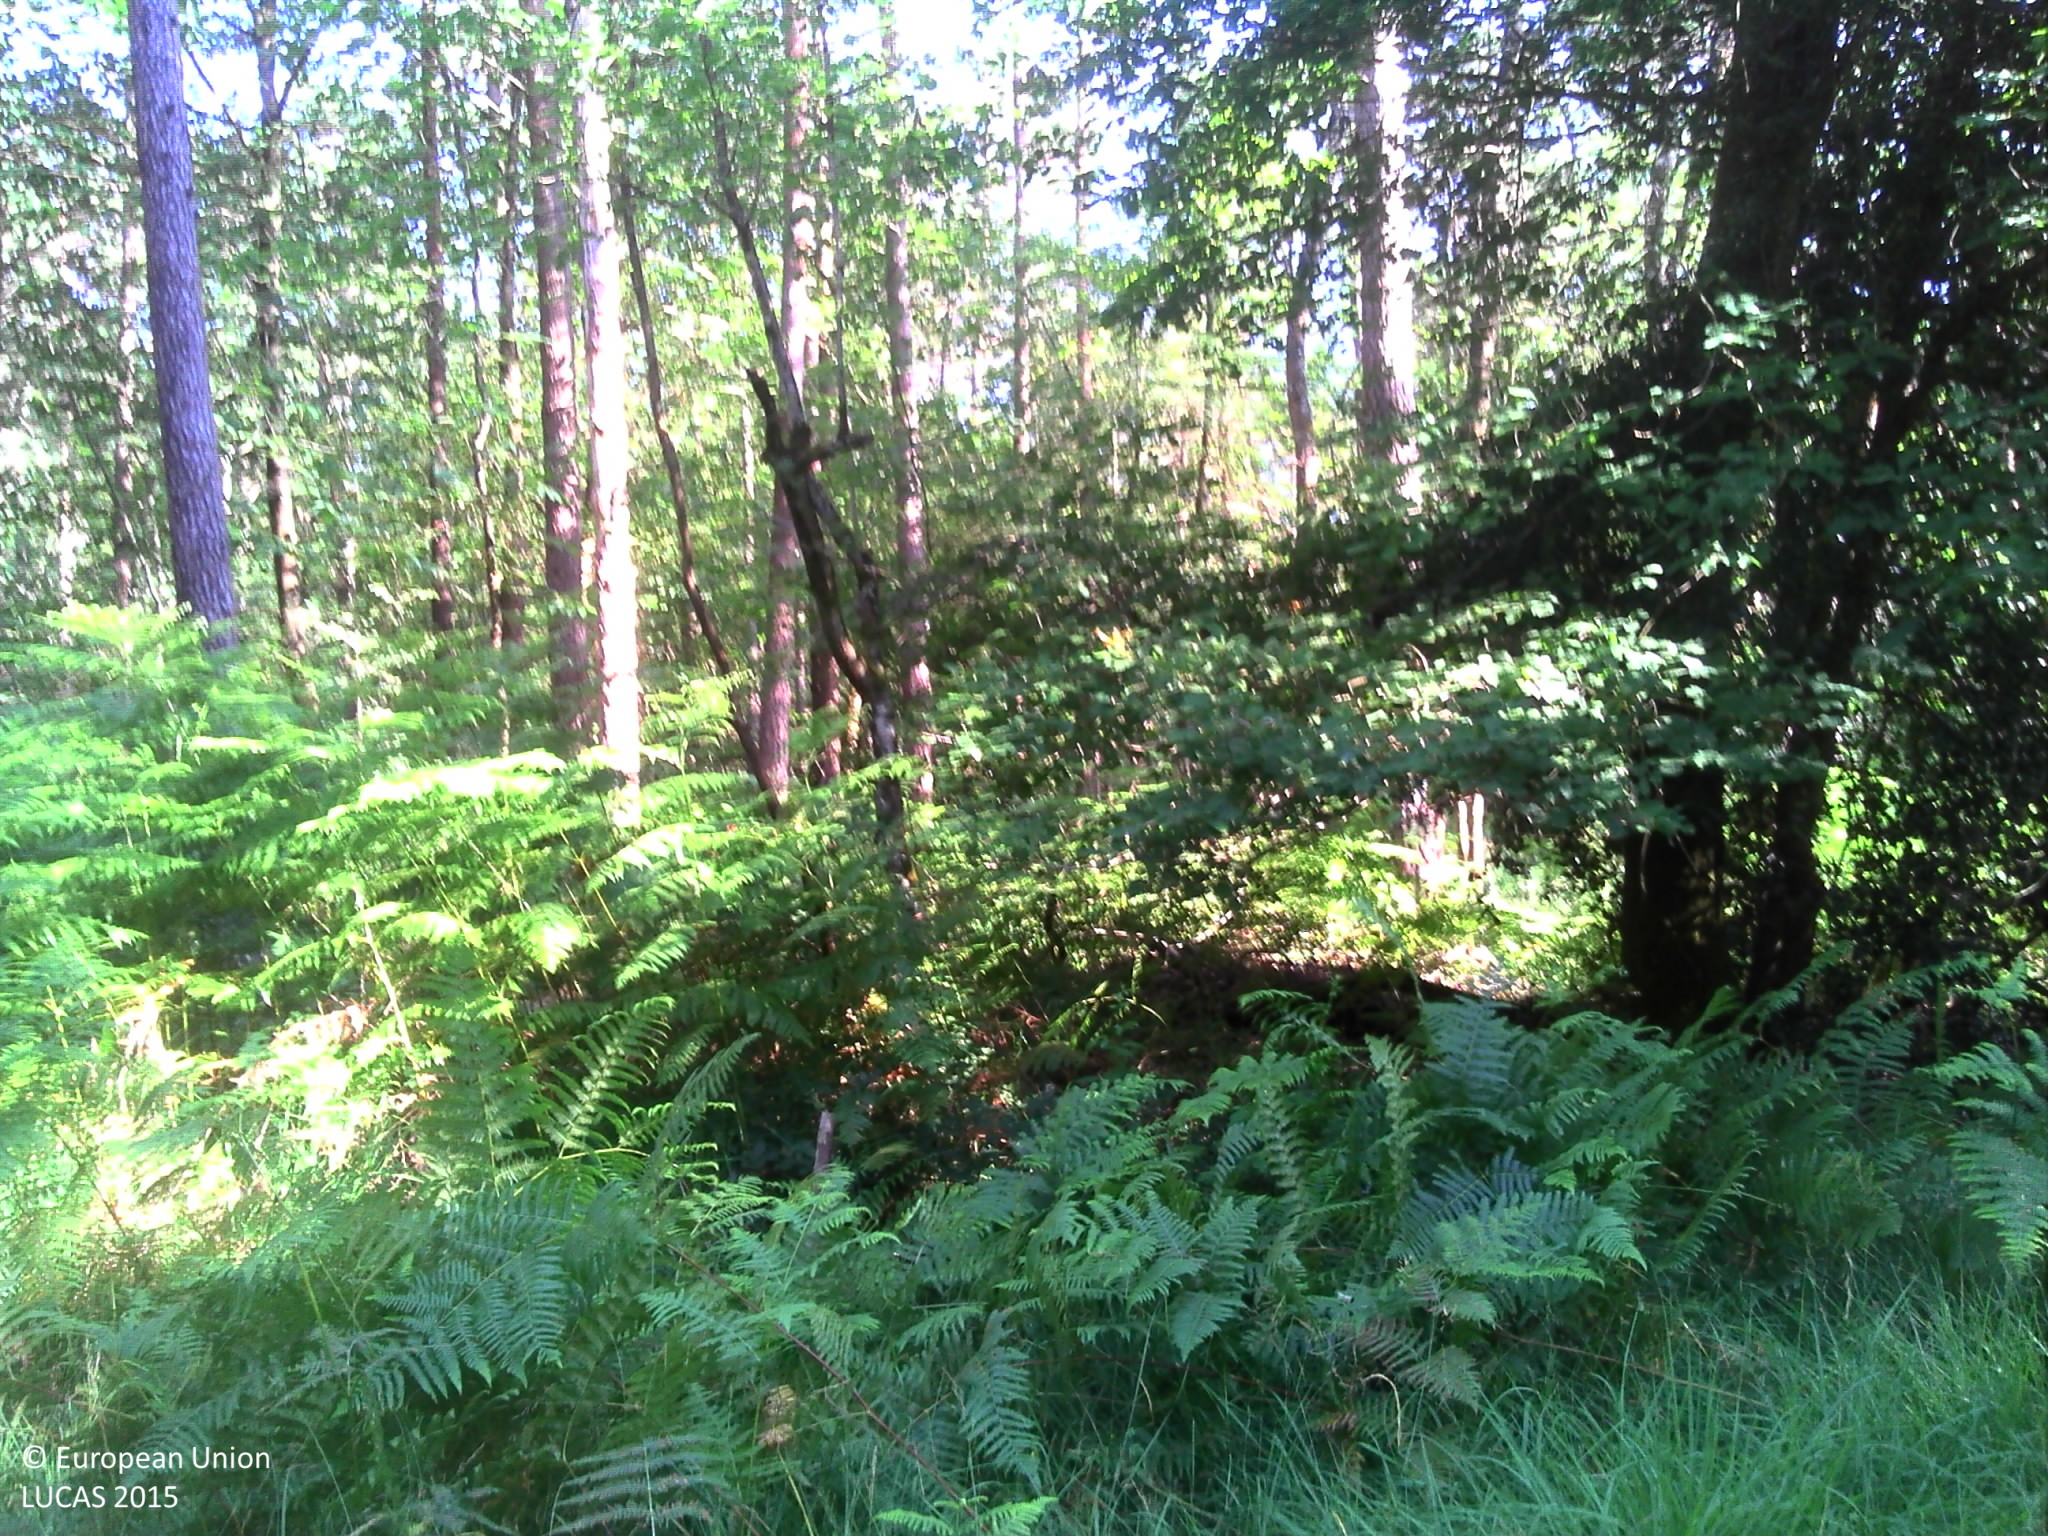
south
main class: Woodland
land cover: Pine dominated mixed woodland
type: mesophytic deciduous forest
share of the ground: > 75 %
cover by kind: coniferous forest trees 35 %, broadleaved forest trees 35 %, herbaceous plants 15 %, shrubs 10 %, lichens and mosses 5 %
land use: Forestry
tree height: > 5 m
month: July
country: FR
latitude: 47.2350
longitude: 0.3222
